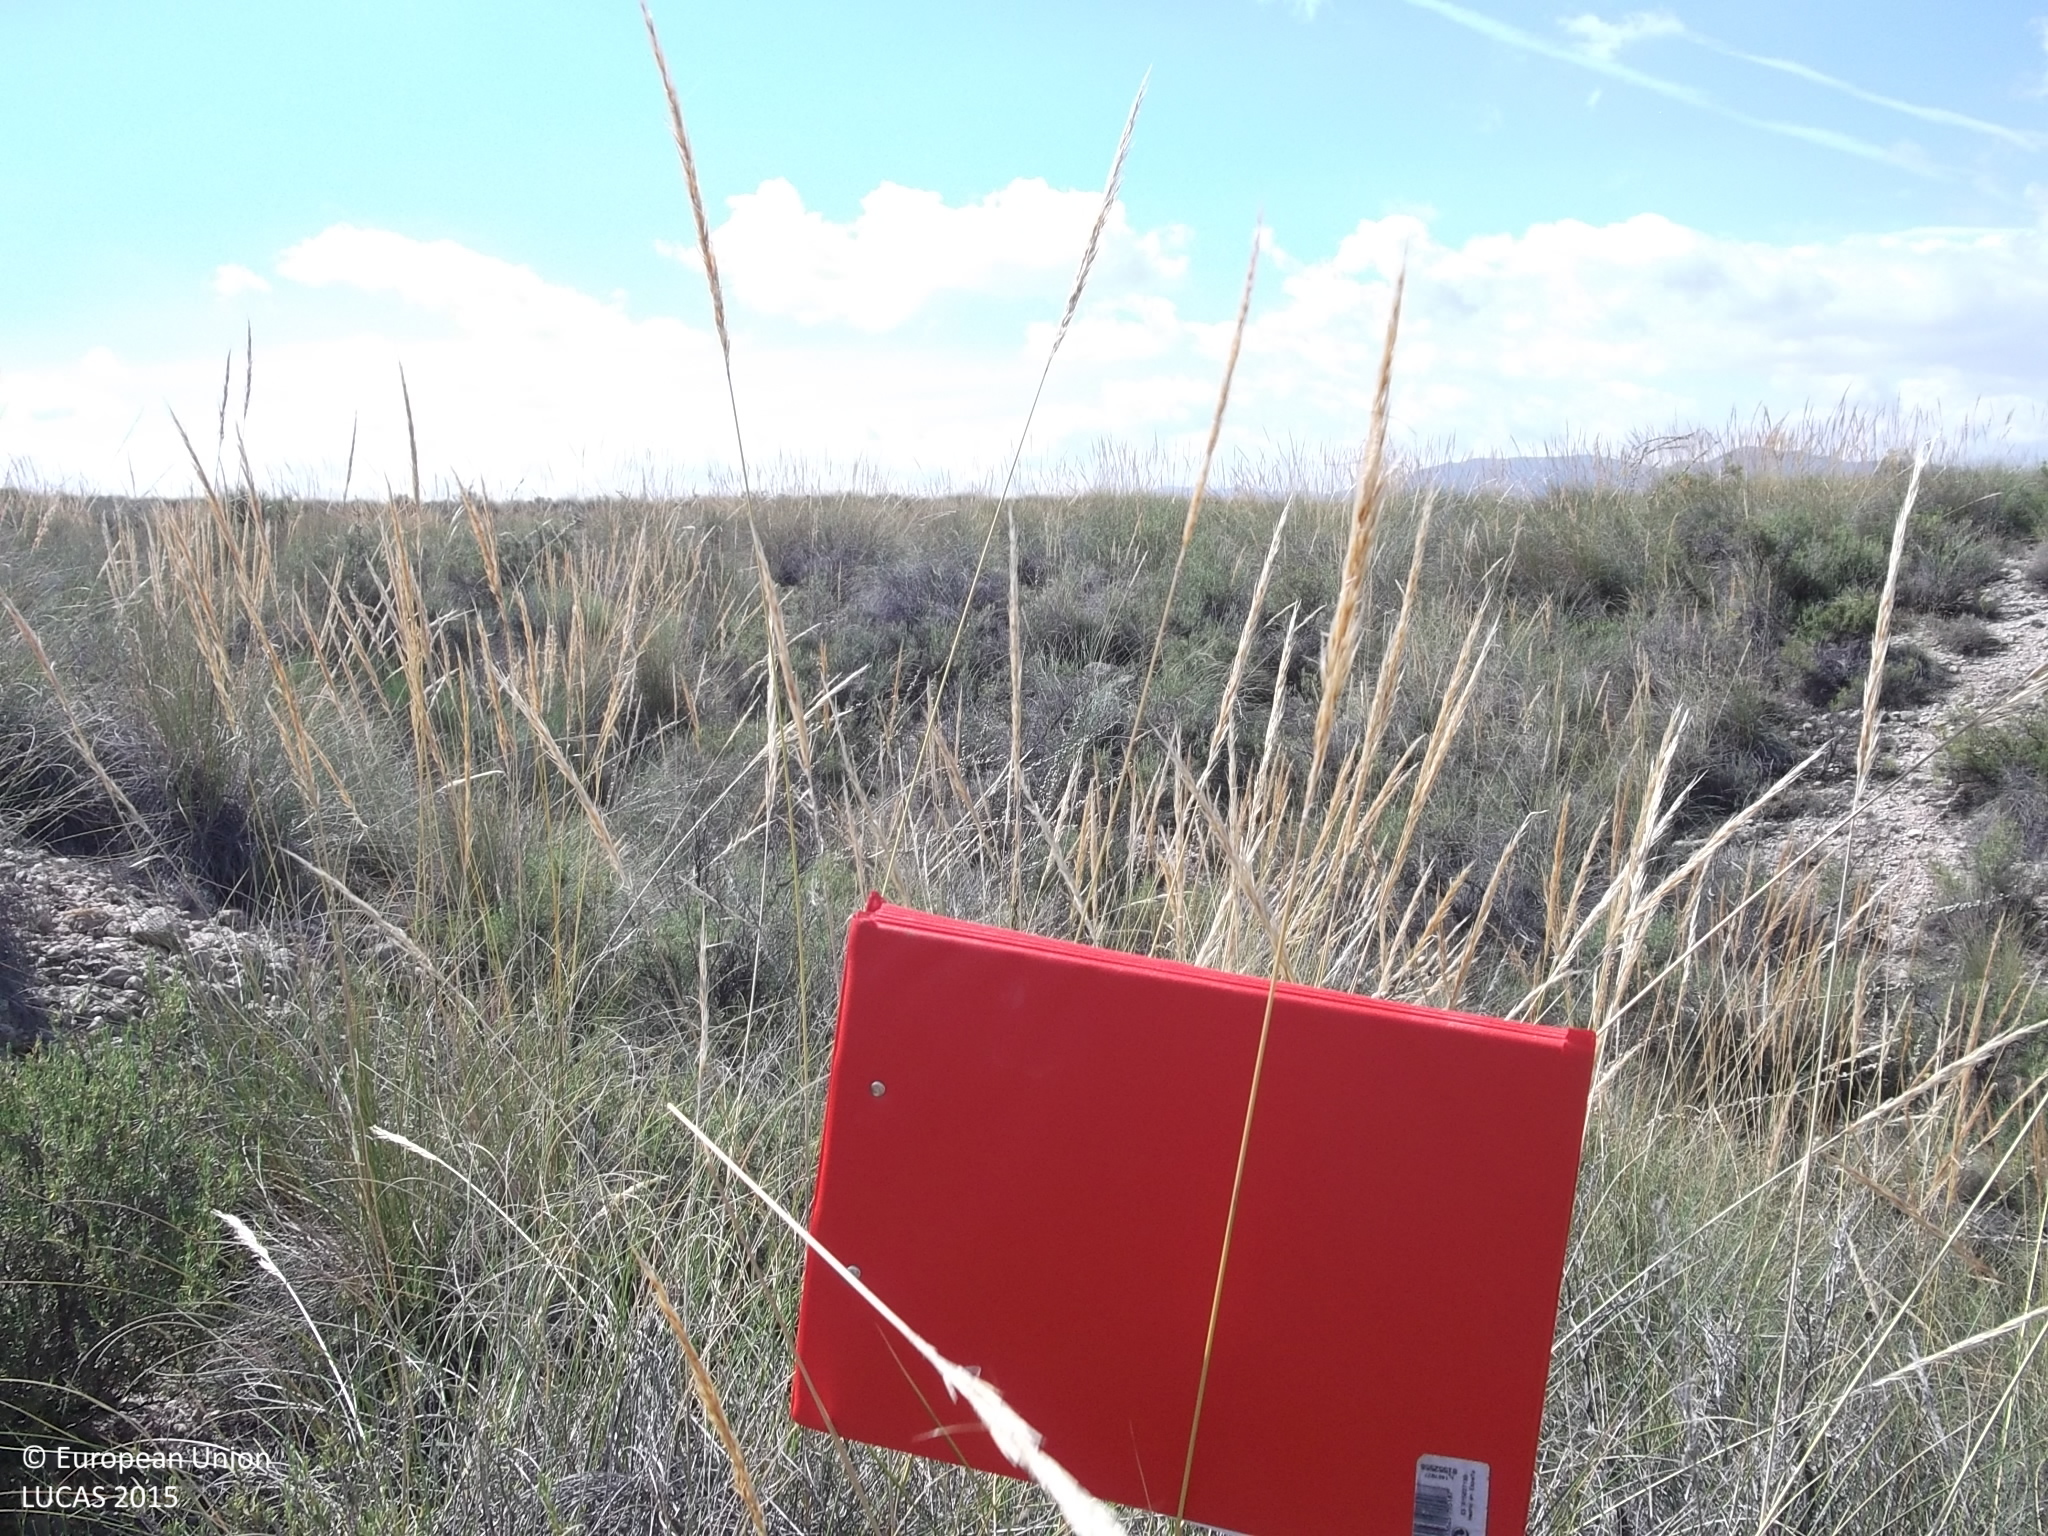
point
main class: Shrubland
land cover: Shrubland without tree cover
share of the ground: 50 - 75 %
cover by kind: shrubs 50 %, herbaceous plants 30 %, consolidated bare surface 20 %
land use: Semi-natural and natural areas not in use
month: May
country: ES
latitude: 38.3144
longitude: -1.4609
